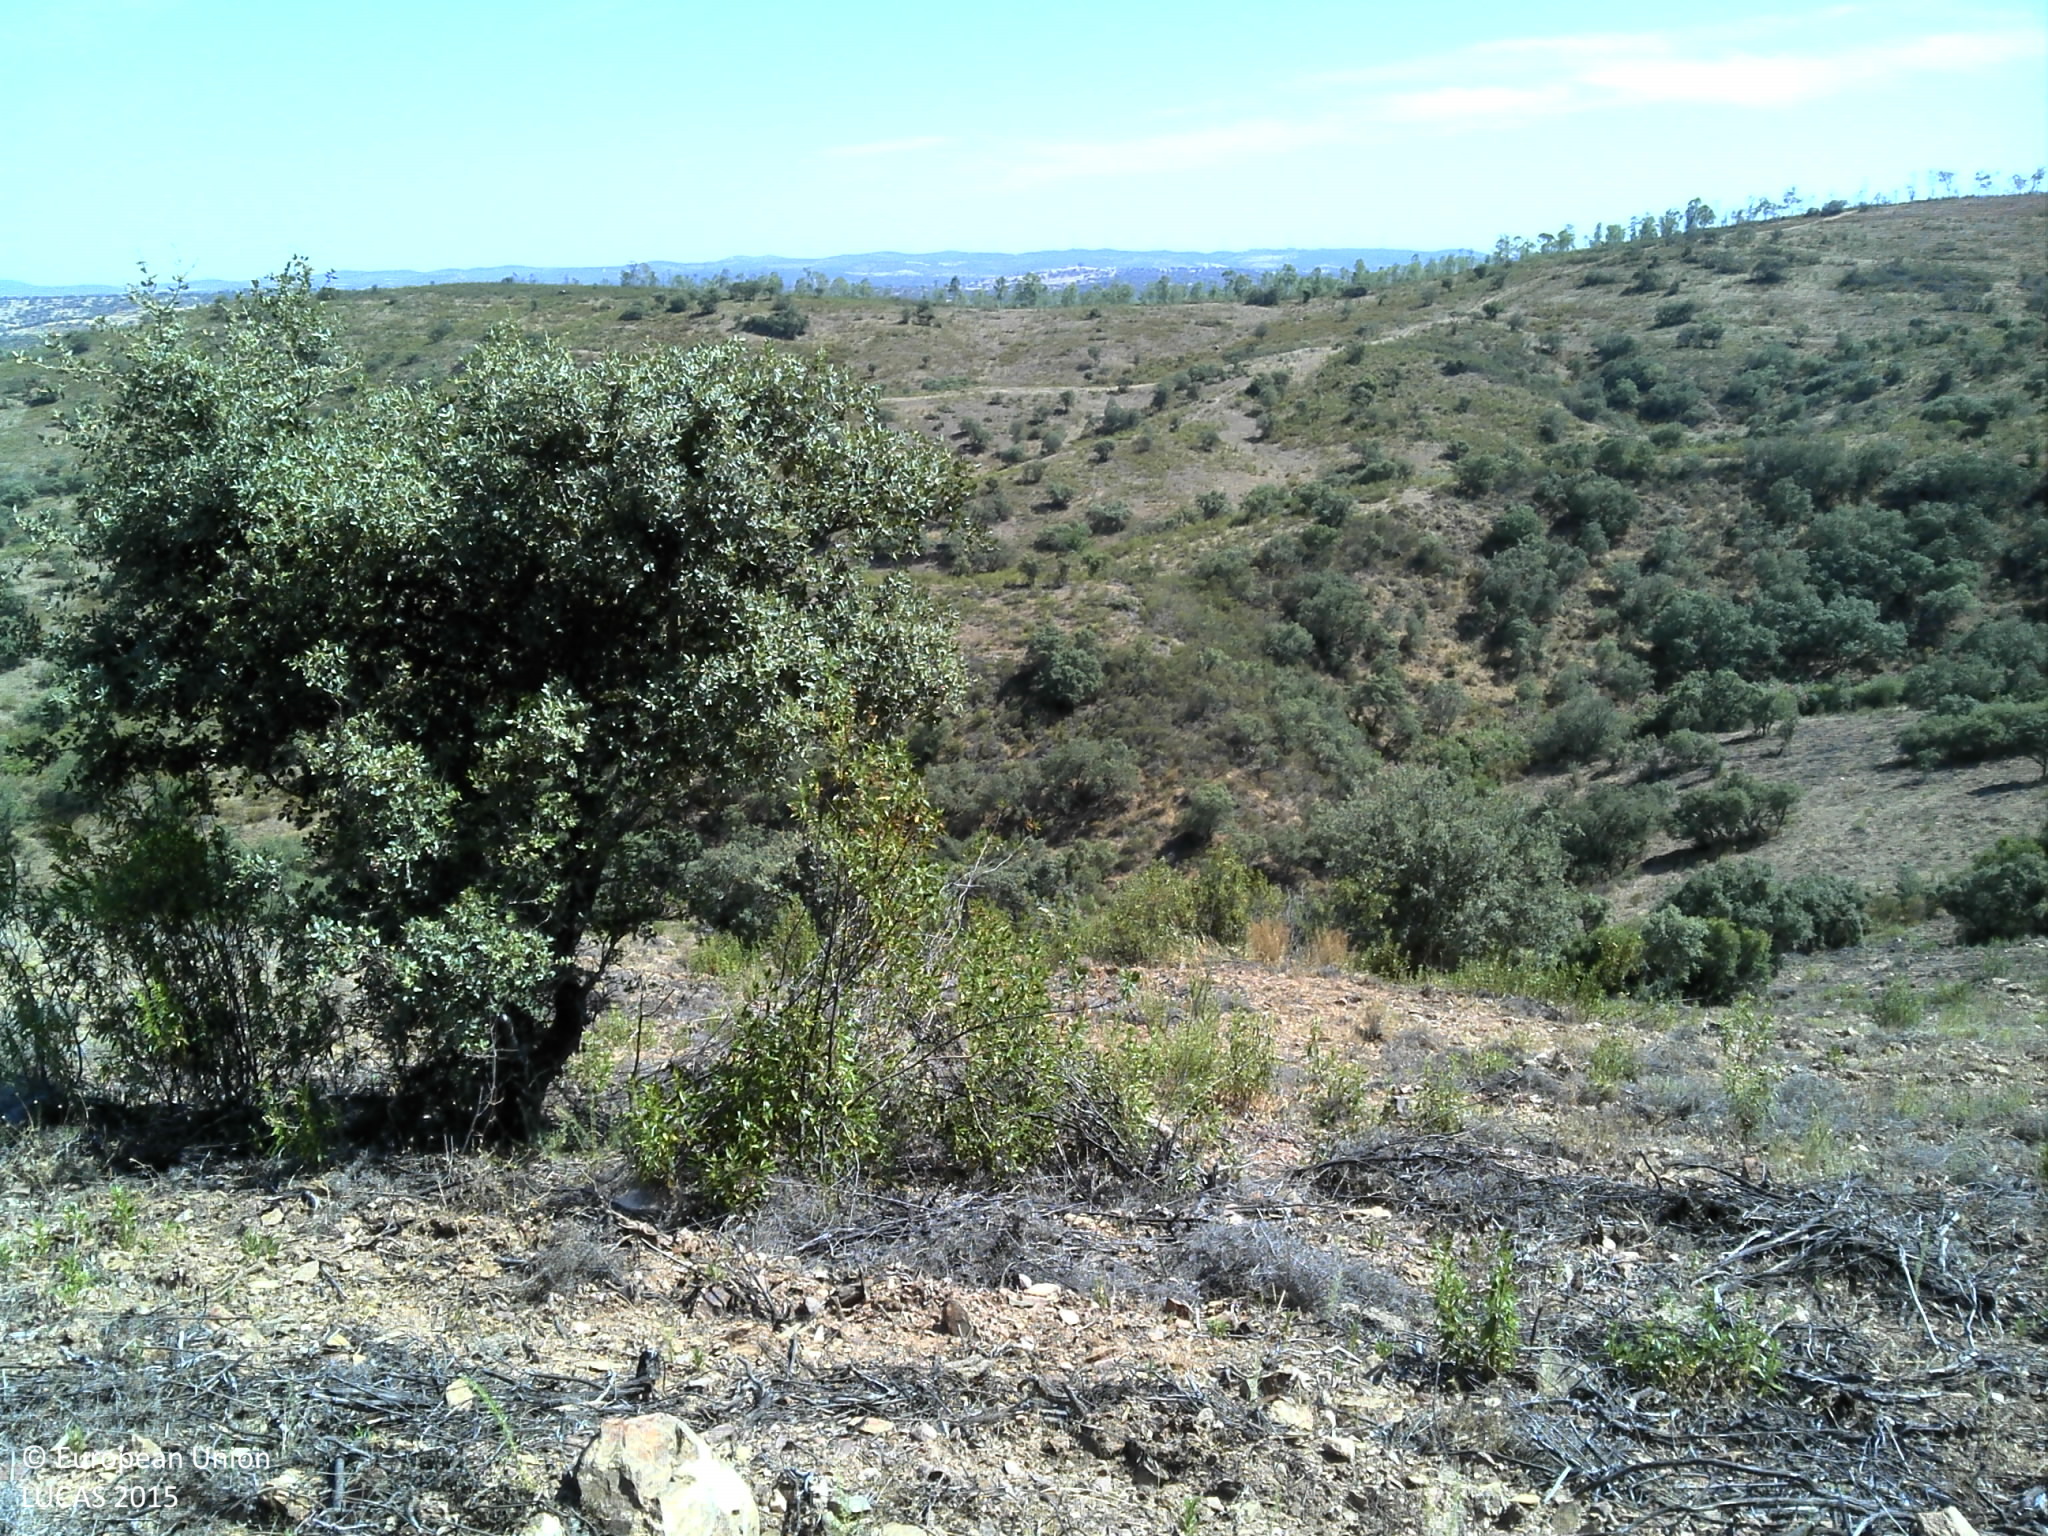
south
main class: Shrubland
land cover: Shrubland with sparse tree cover
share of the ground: 10 - 25 %
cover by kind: unconsolidated bare surface 60 %, shrubs 20 %, herbaceous plants 15 %, broadleaved forest trees 5 %
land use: Agriculture (excluding fallow land and kitchen gardens)
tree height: > 5 m
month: June
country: PT
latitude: 37.6501
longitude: -7.4779
